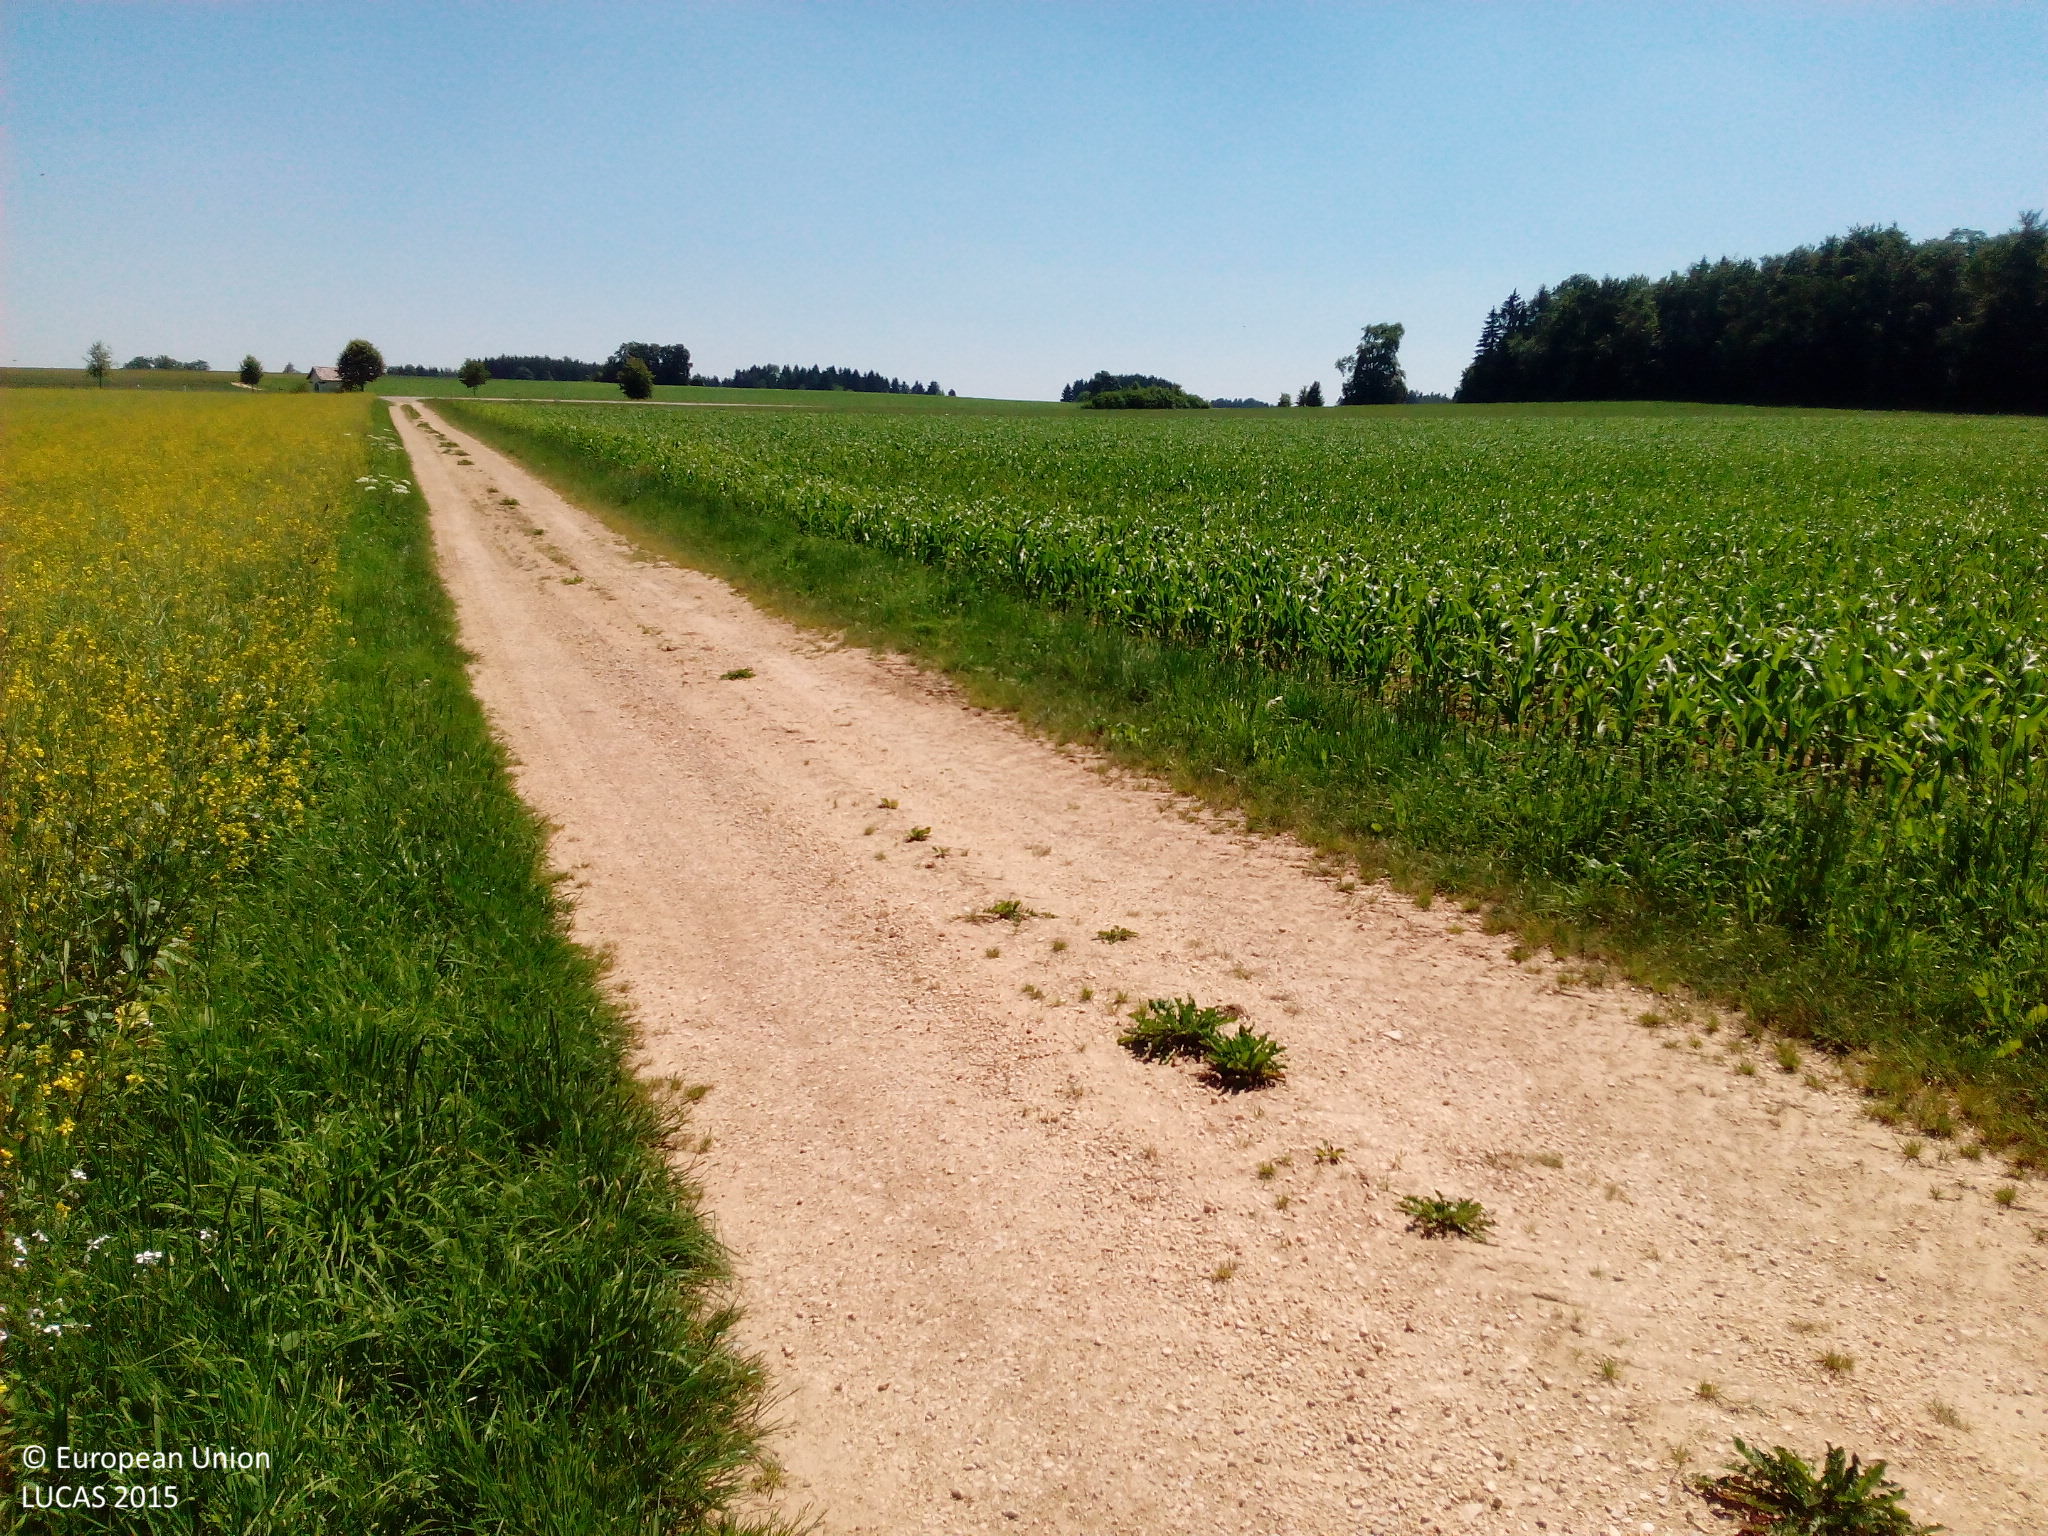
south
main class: Cropland
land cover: Rape and turnip rape
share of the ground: > 75 %
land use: Agriculture (excluding fallow land and kitchen gardens)
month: July
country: DE
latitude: 48.3120
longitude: 9.4205
